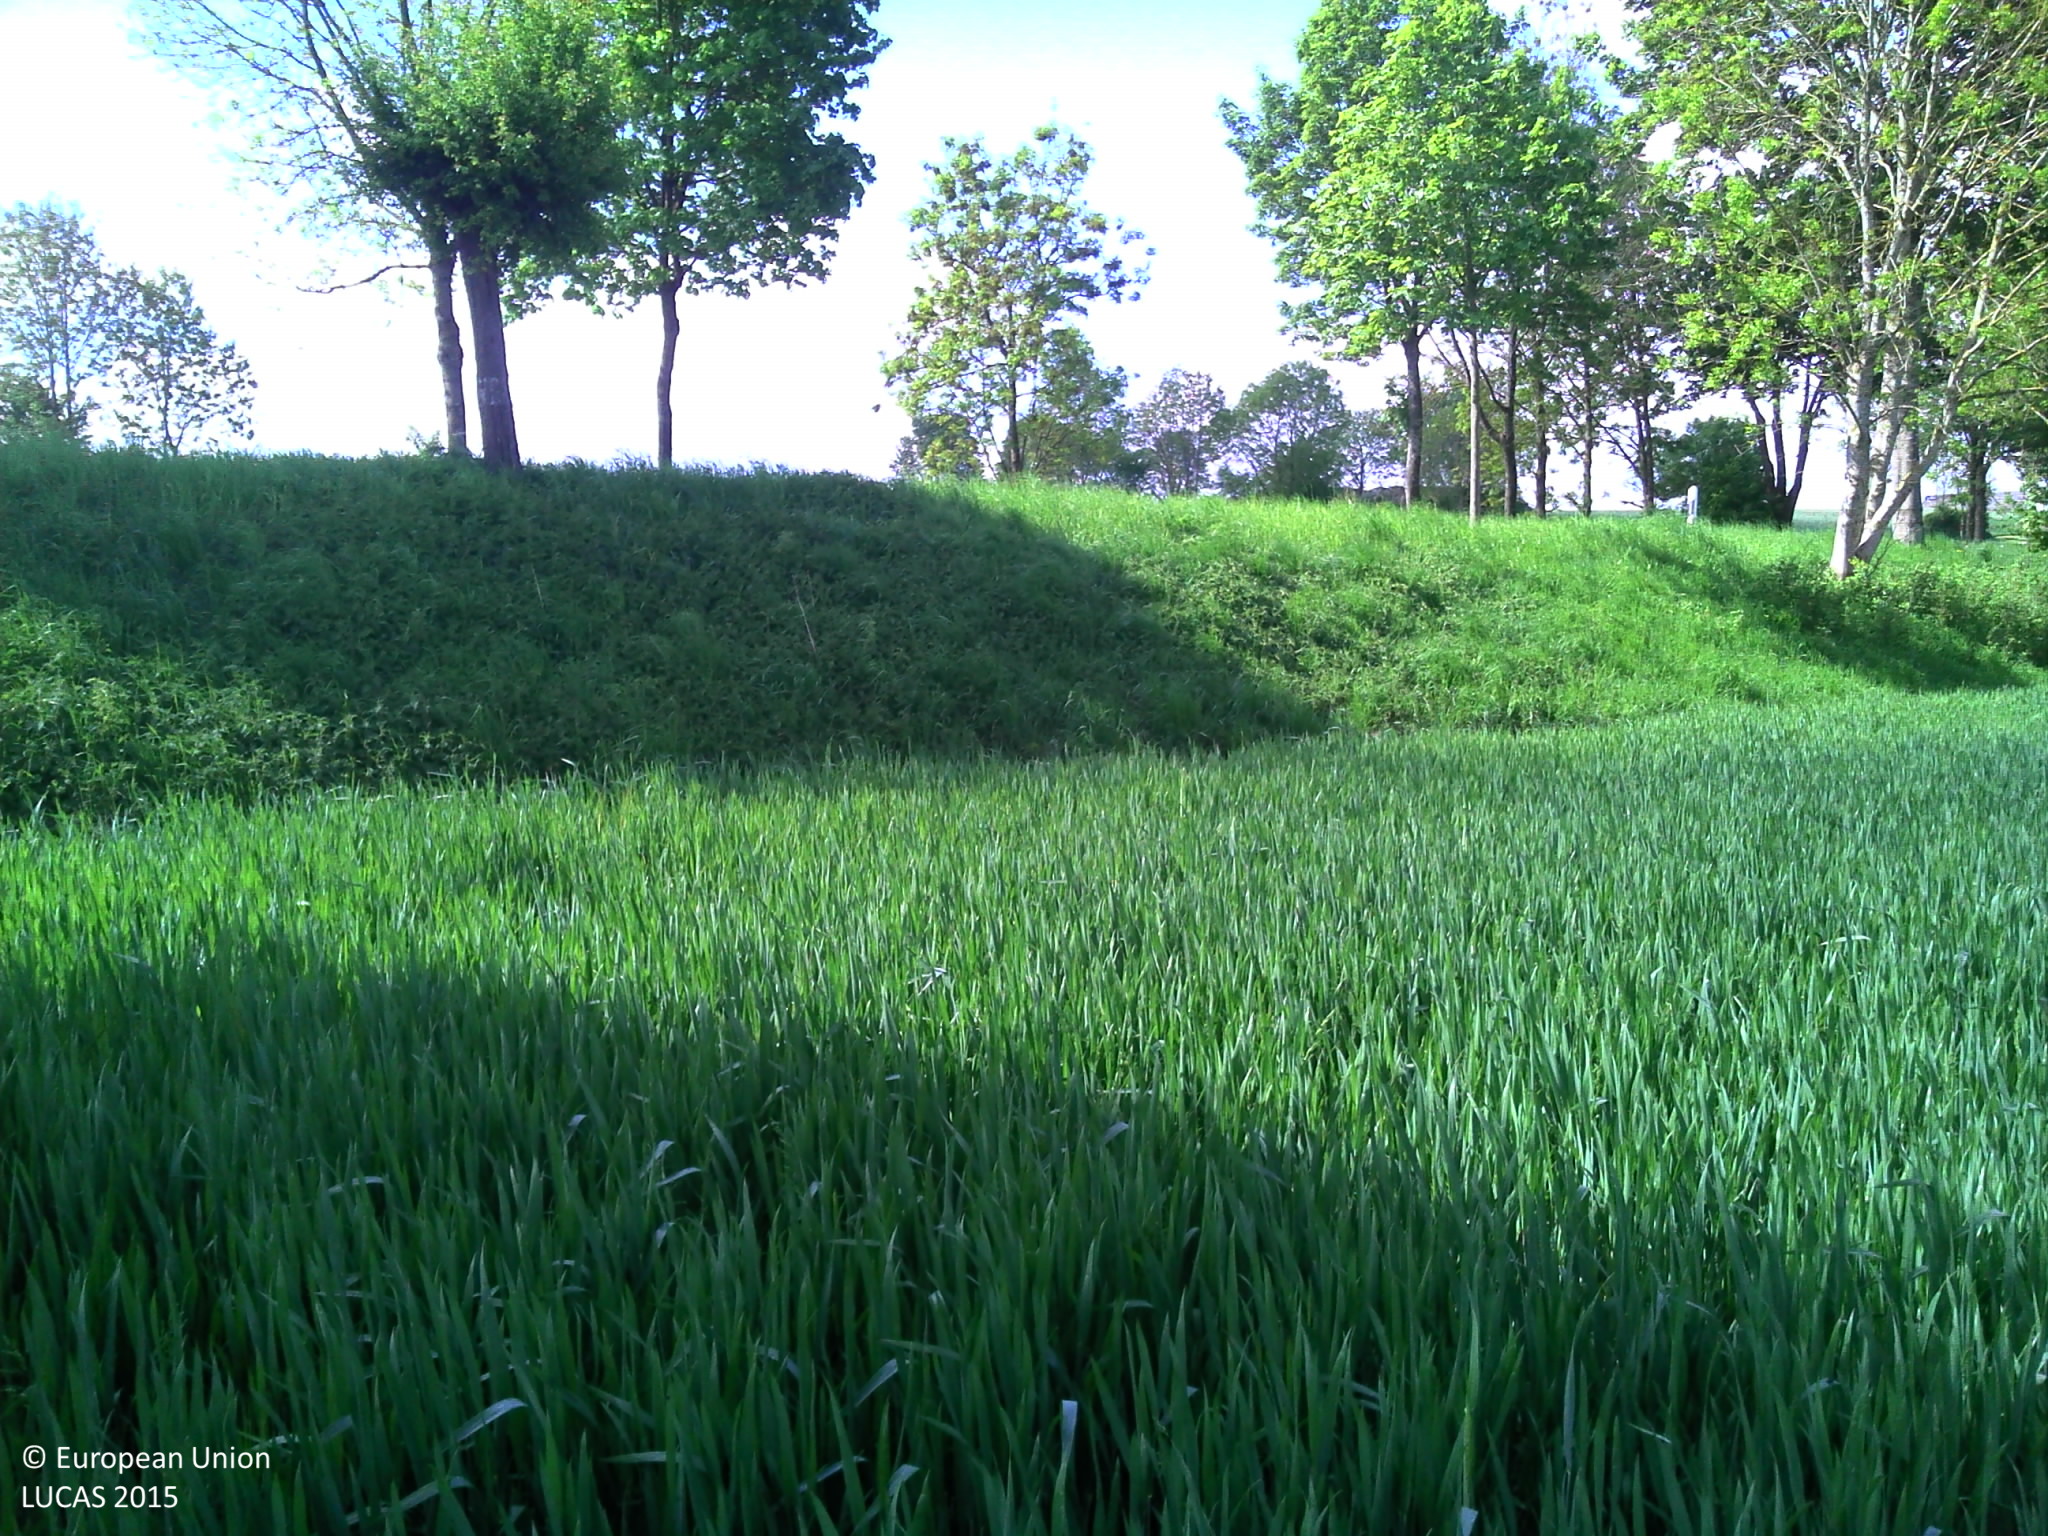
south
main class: Cropland
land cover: Common wheat
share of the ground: > 75 %
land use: Agriculture (excluding fallow land and kitchen gardens)
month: May
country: LU
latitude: 50.1325
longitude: 6.0120
